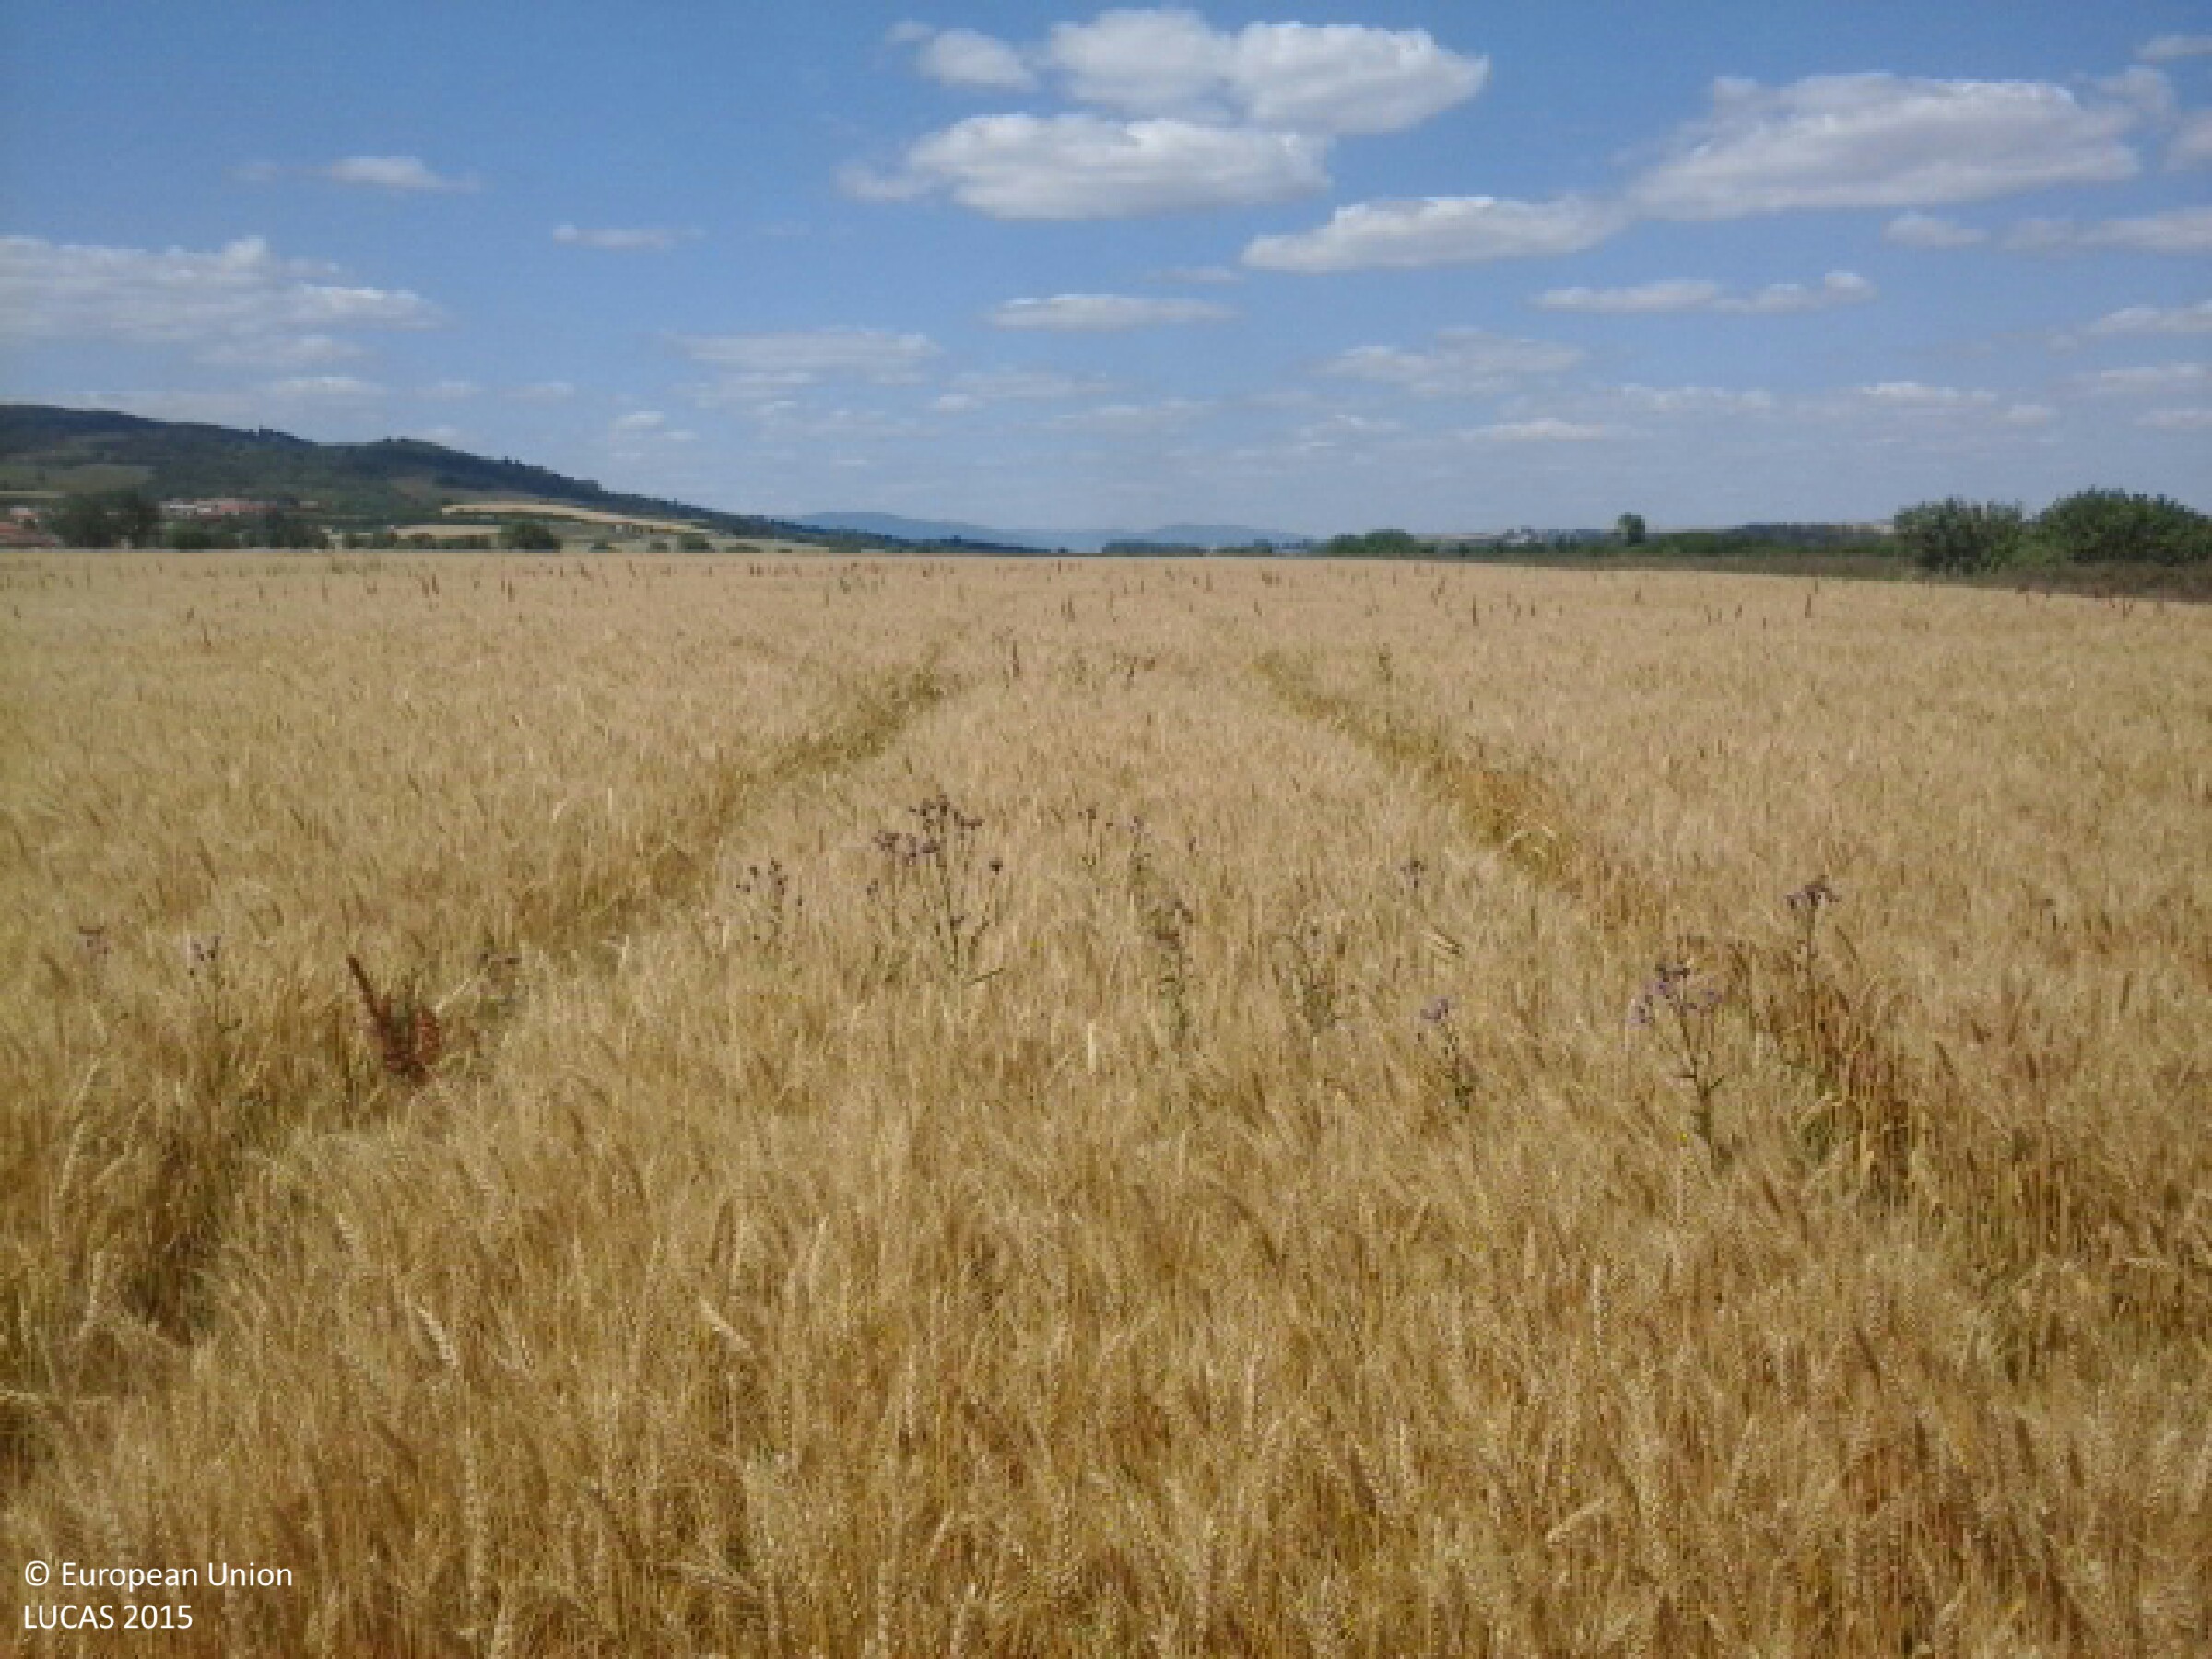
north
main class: Cropland
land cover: Triticale
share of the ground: > 75 %
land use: Agriculture (excluding fallow land and kitchen gardens)
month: July
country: HU
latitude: 48.4797
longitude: 21.6152
